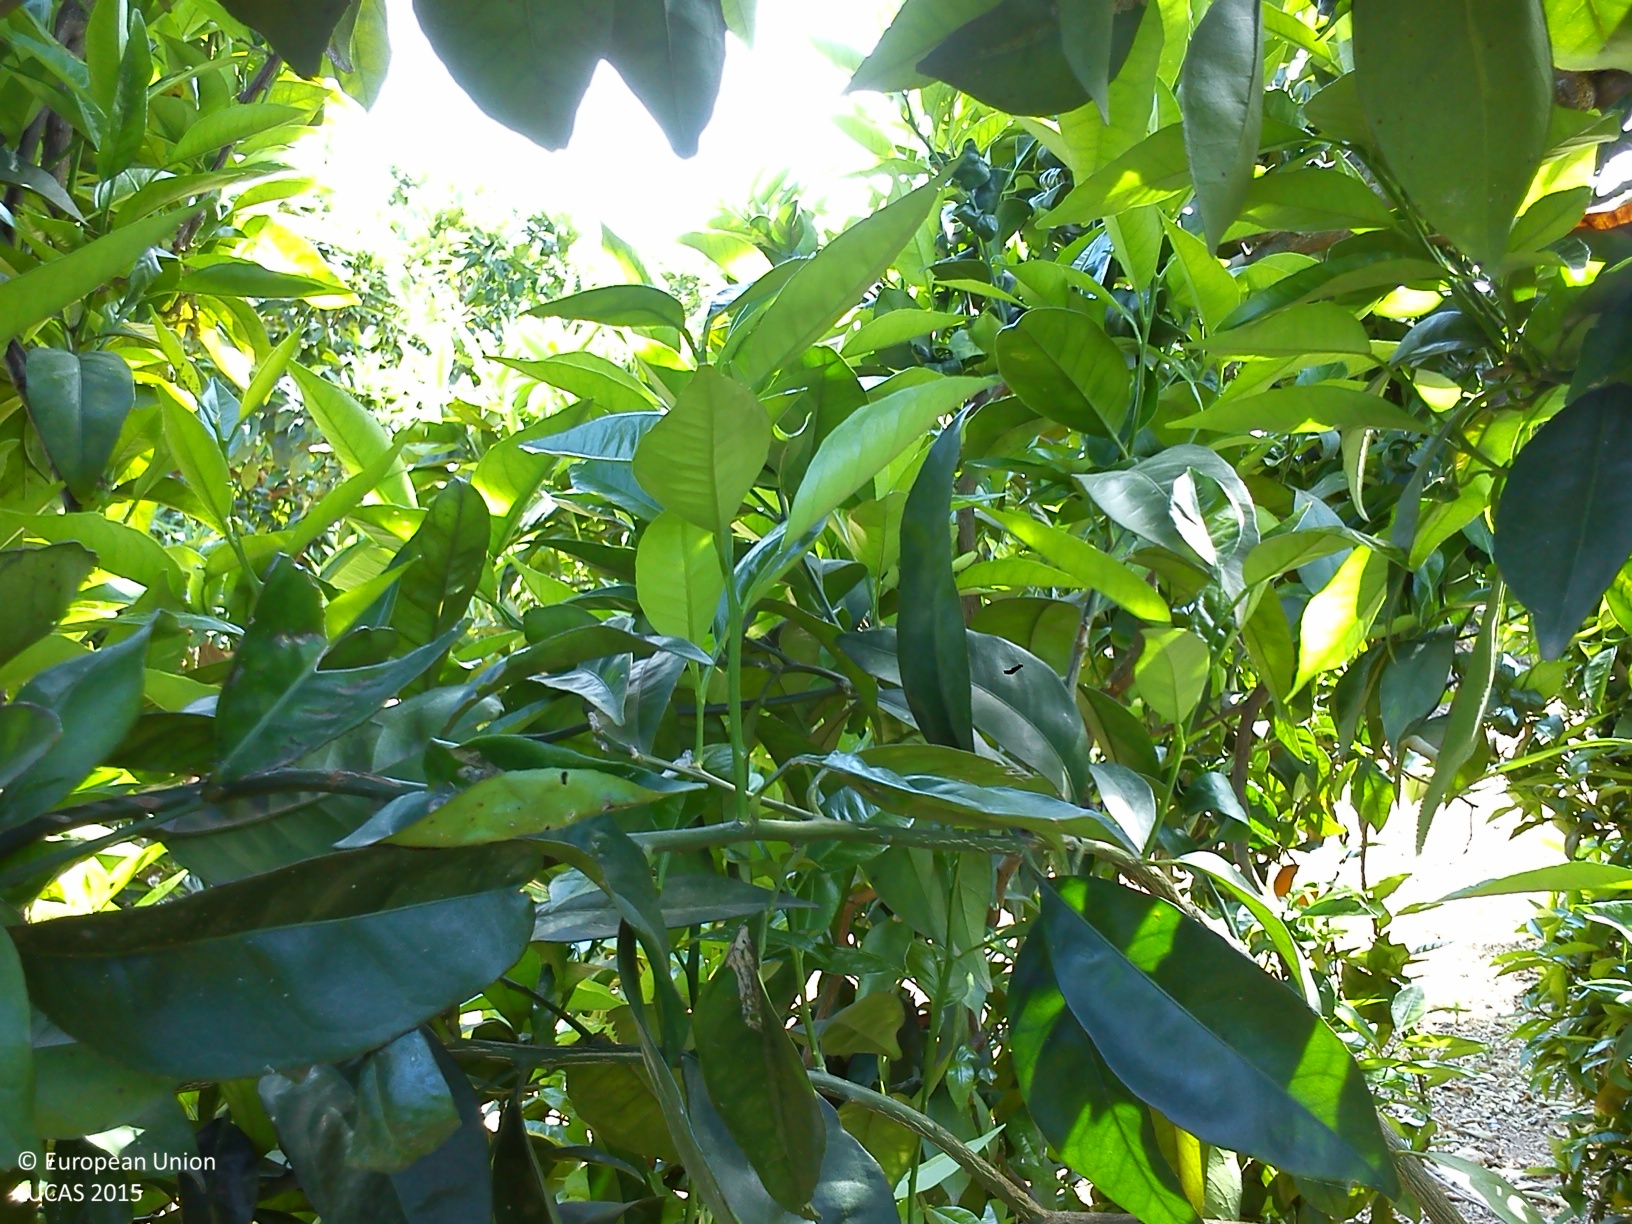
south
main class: Cropland
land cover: Oranges
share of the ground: > 75 %
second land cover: Other bare soil
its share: > 75 %
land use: Agriculture (excluding fallow land and kitchen gardens)
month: April
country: ES
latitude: 39.4688
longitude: -0.6342
